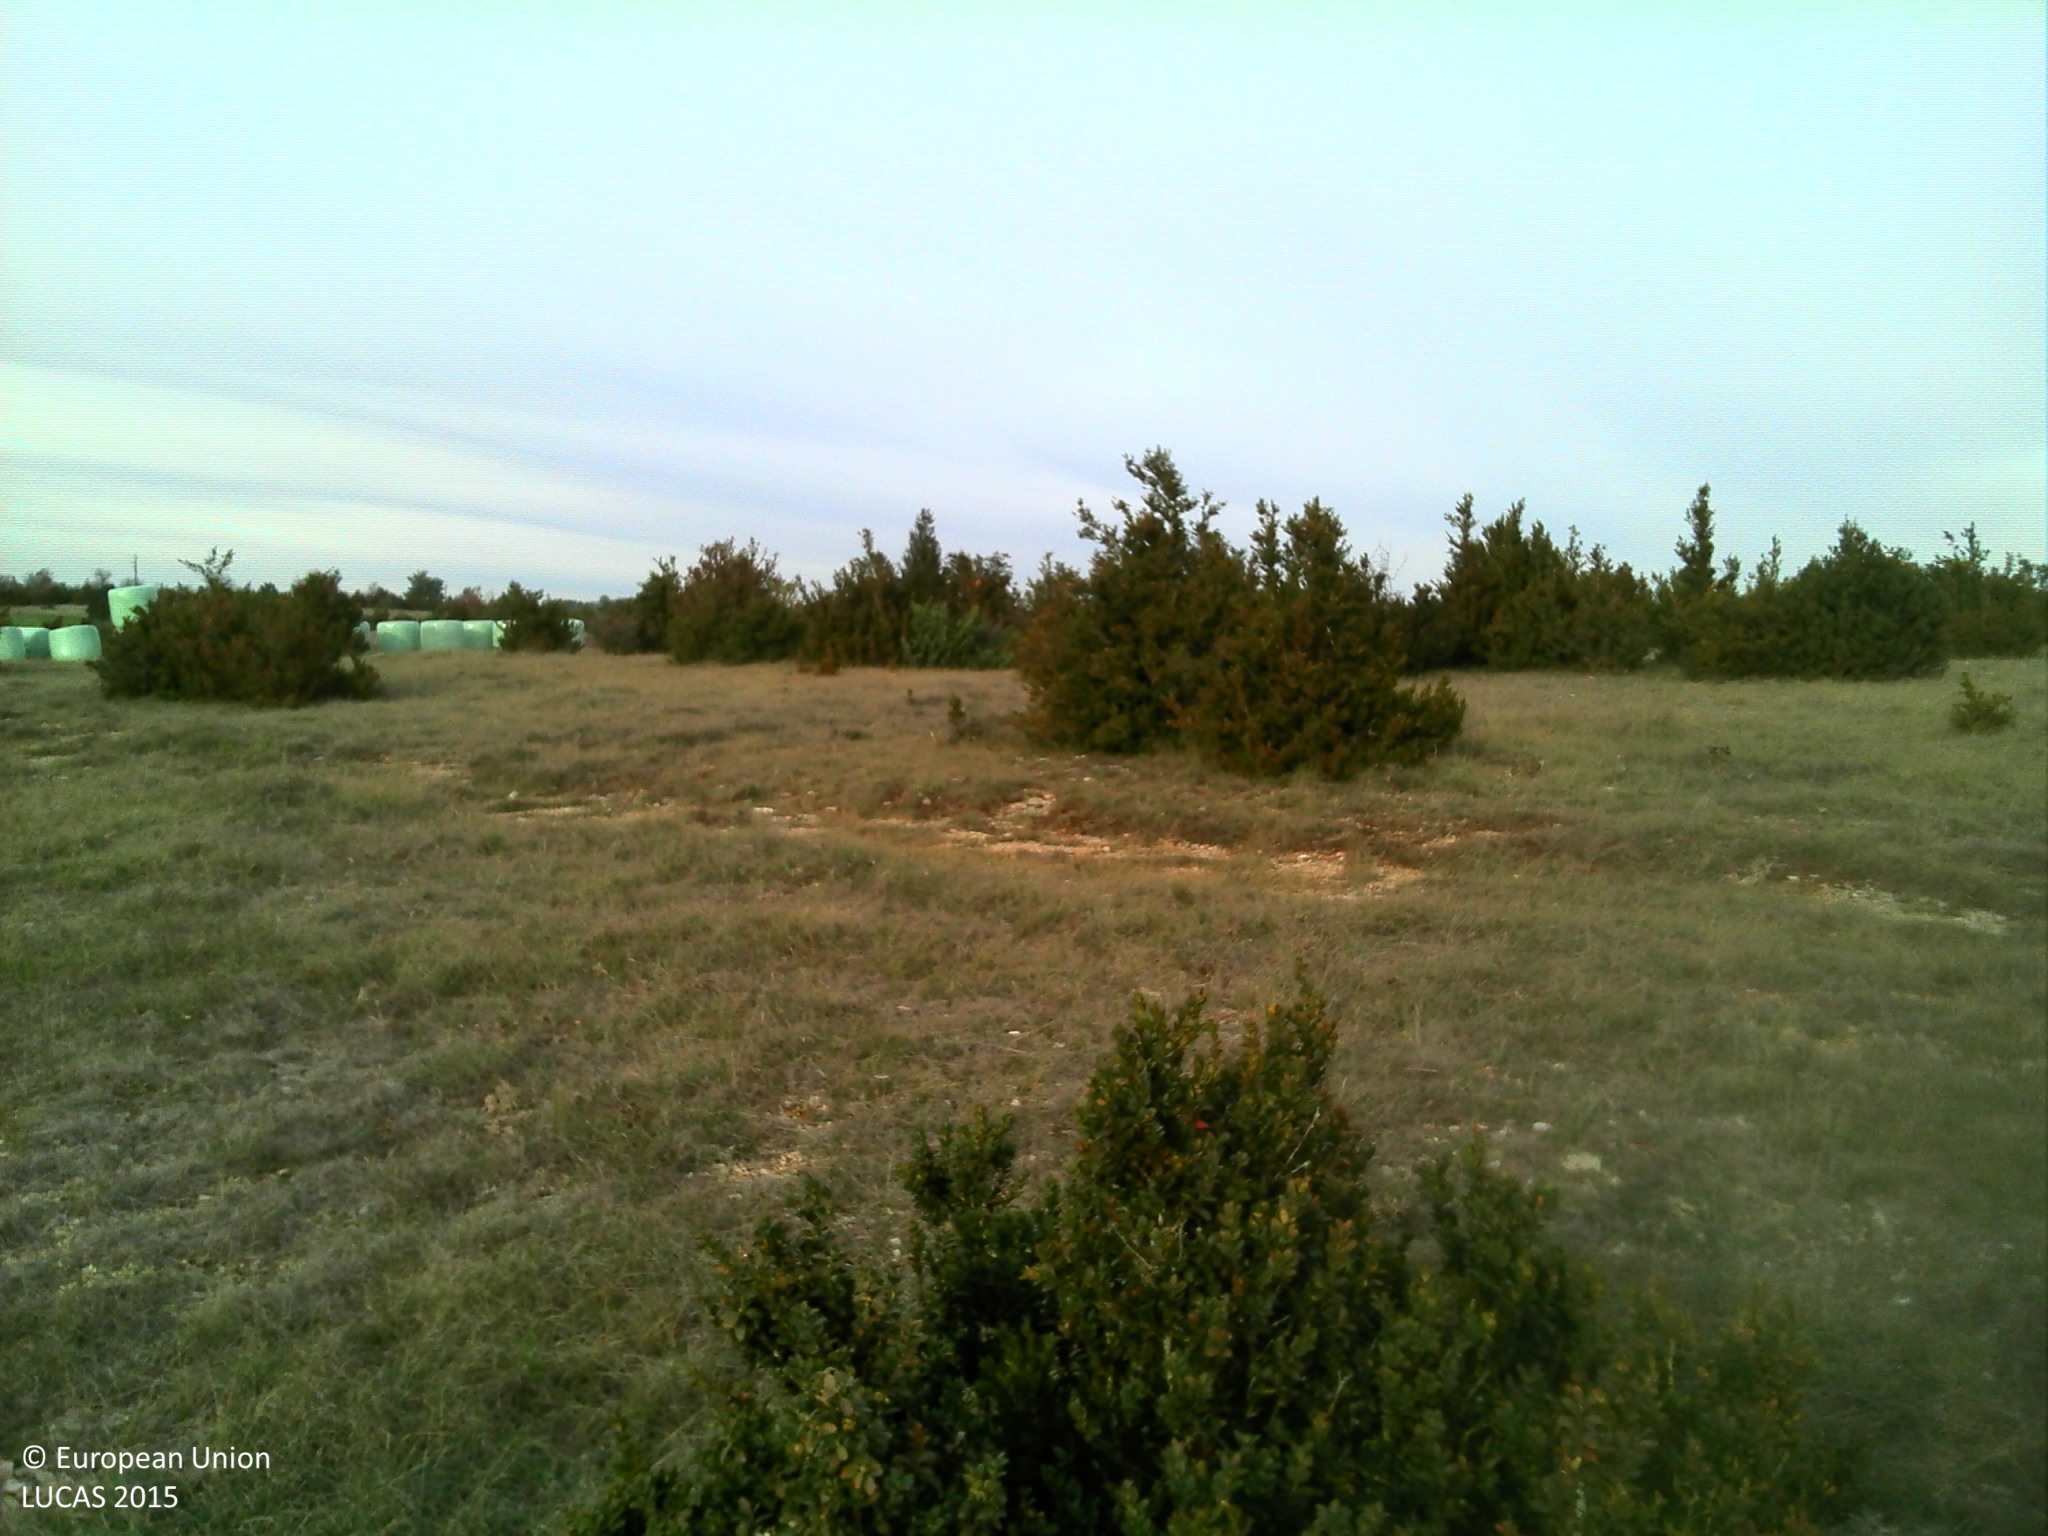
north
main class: Shrubland
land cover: Shrubland with sparse tree cover
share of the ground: > 75 %
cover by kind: herbaceous plants 70 %, shrubs 15 %, broadleaved forest trees 5 %, consolidated bare surface 5 %, unconsolidated bare surface 5 %
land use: Agriculture (excluding fallow land and kitchen gardens)
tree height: < 5 m
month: November
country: FR
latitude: 44.0699
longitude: 3.1516
